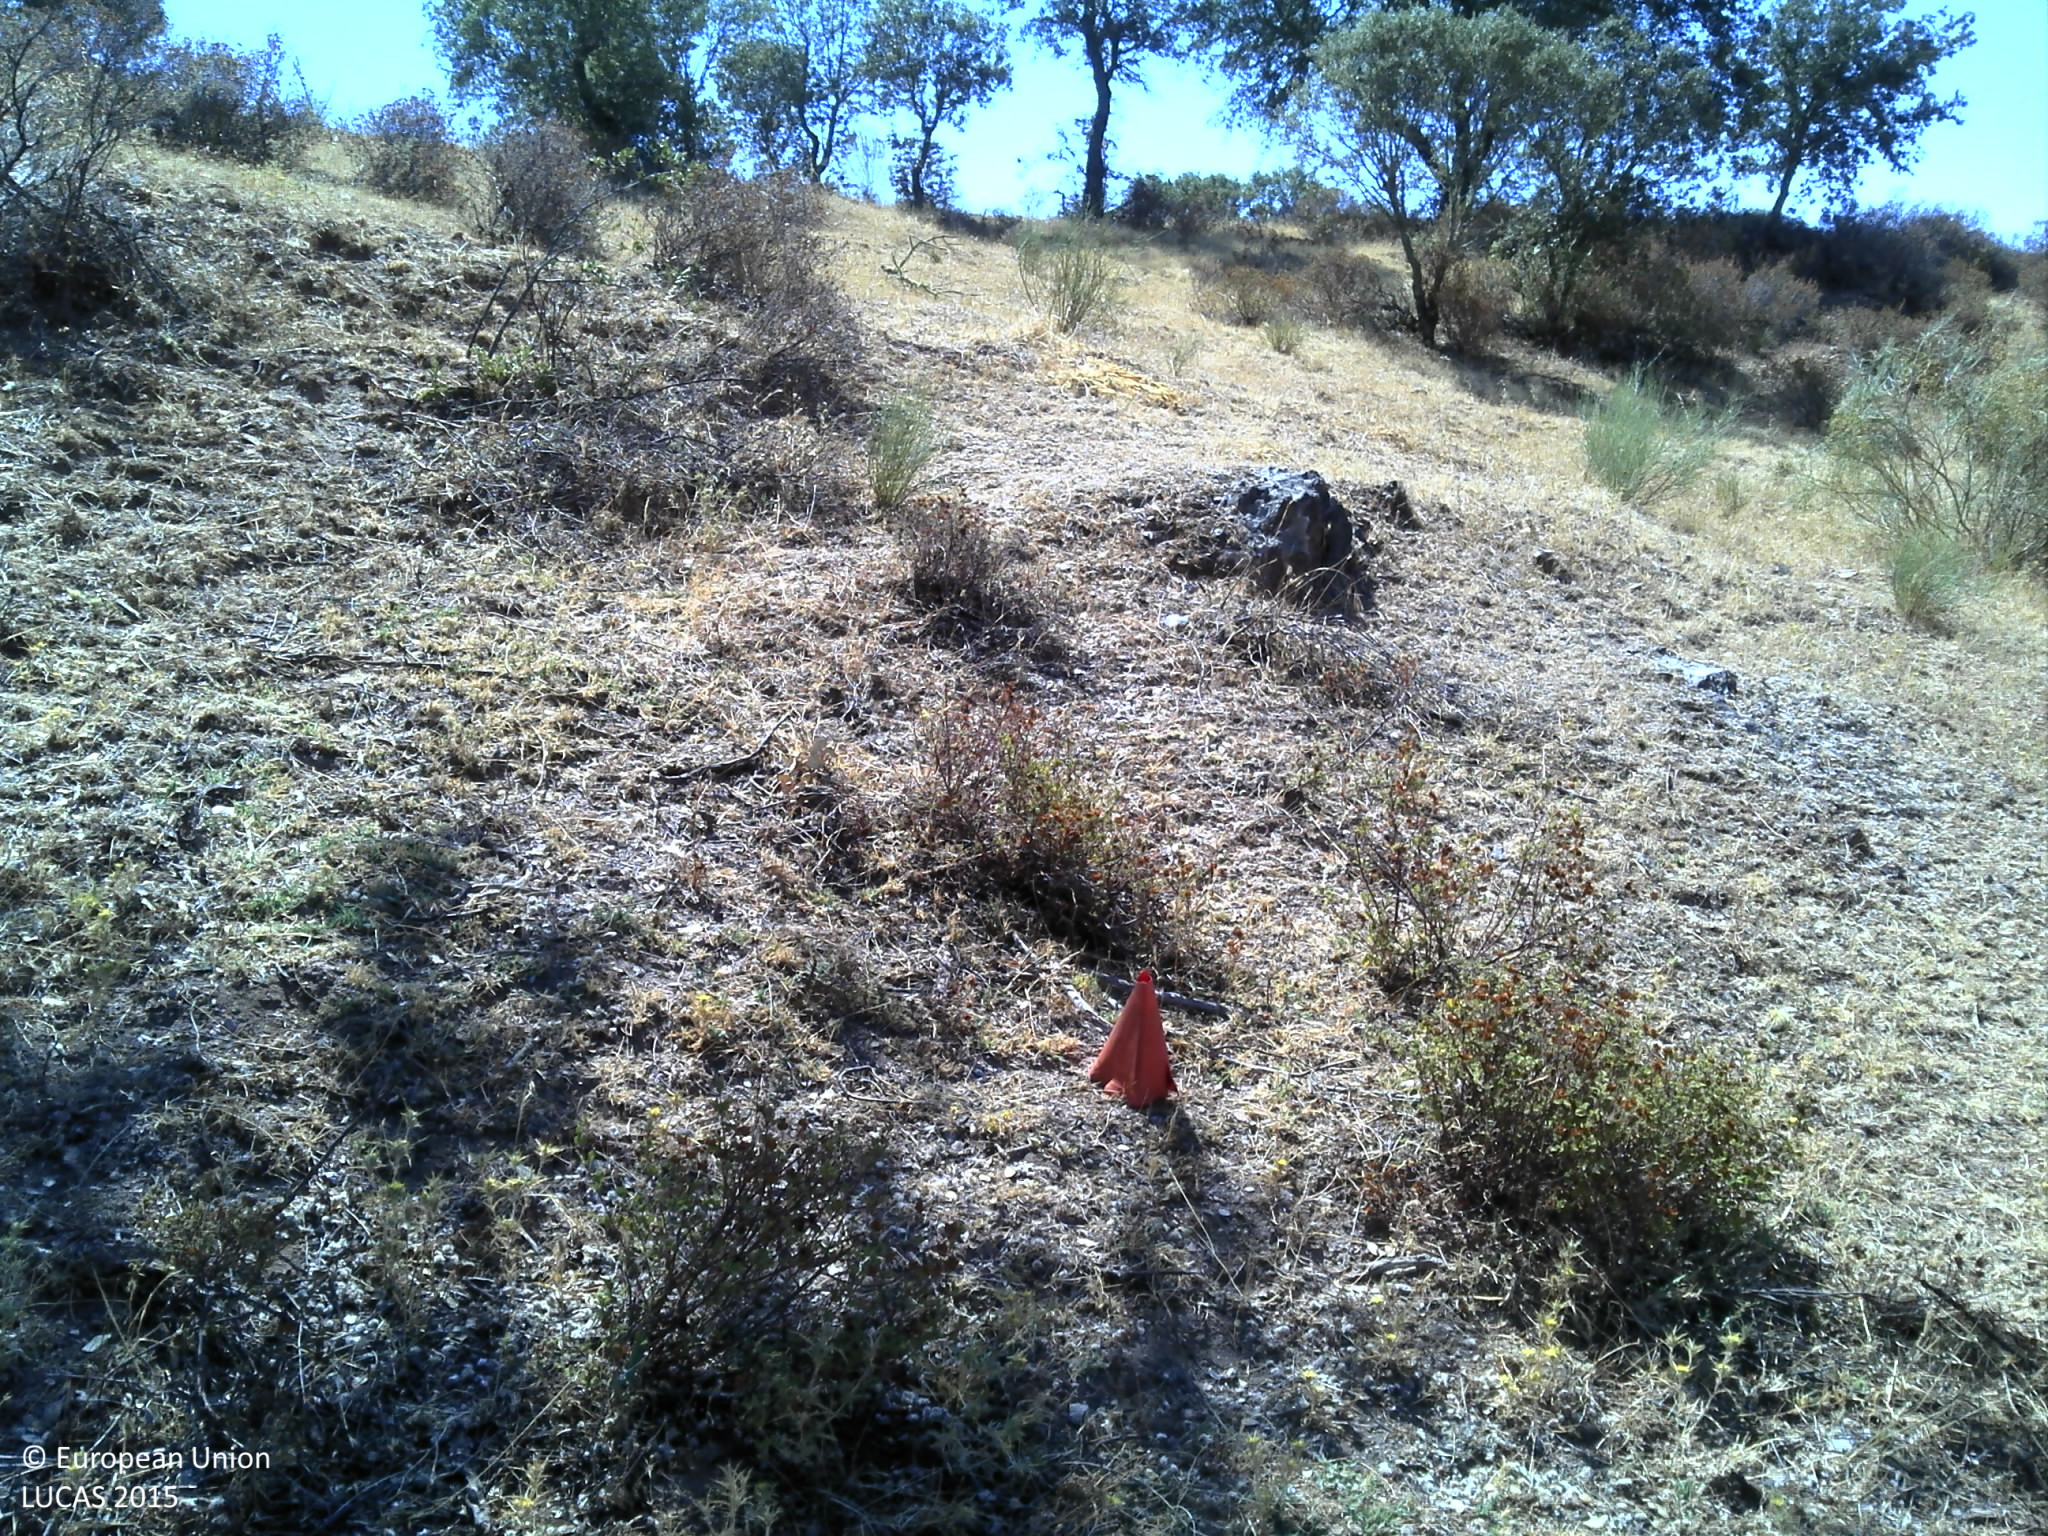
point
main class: Woodland
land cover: Broadleaved woodland
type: broadleaved evergreen forest
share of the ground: 10 - 25 %
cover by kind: broadleaved forest trees 20 %, shrubs 20 %, herbaceous plants 20 %, unconsolidated bare surface 20 %
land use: Forestry
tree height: > 5 m
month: August
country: PT
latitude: 37.9172
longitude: -7.8270
